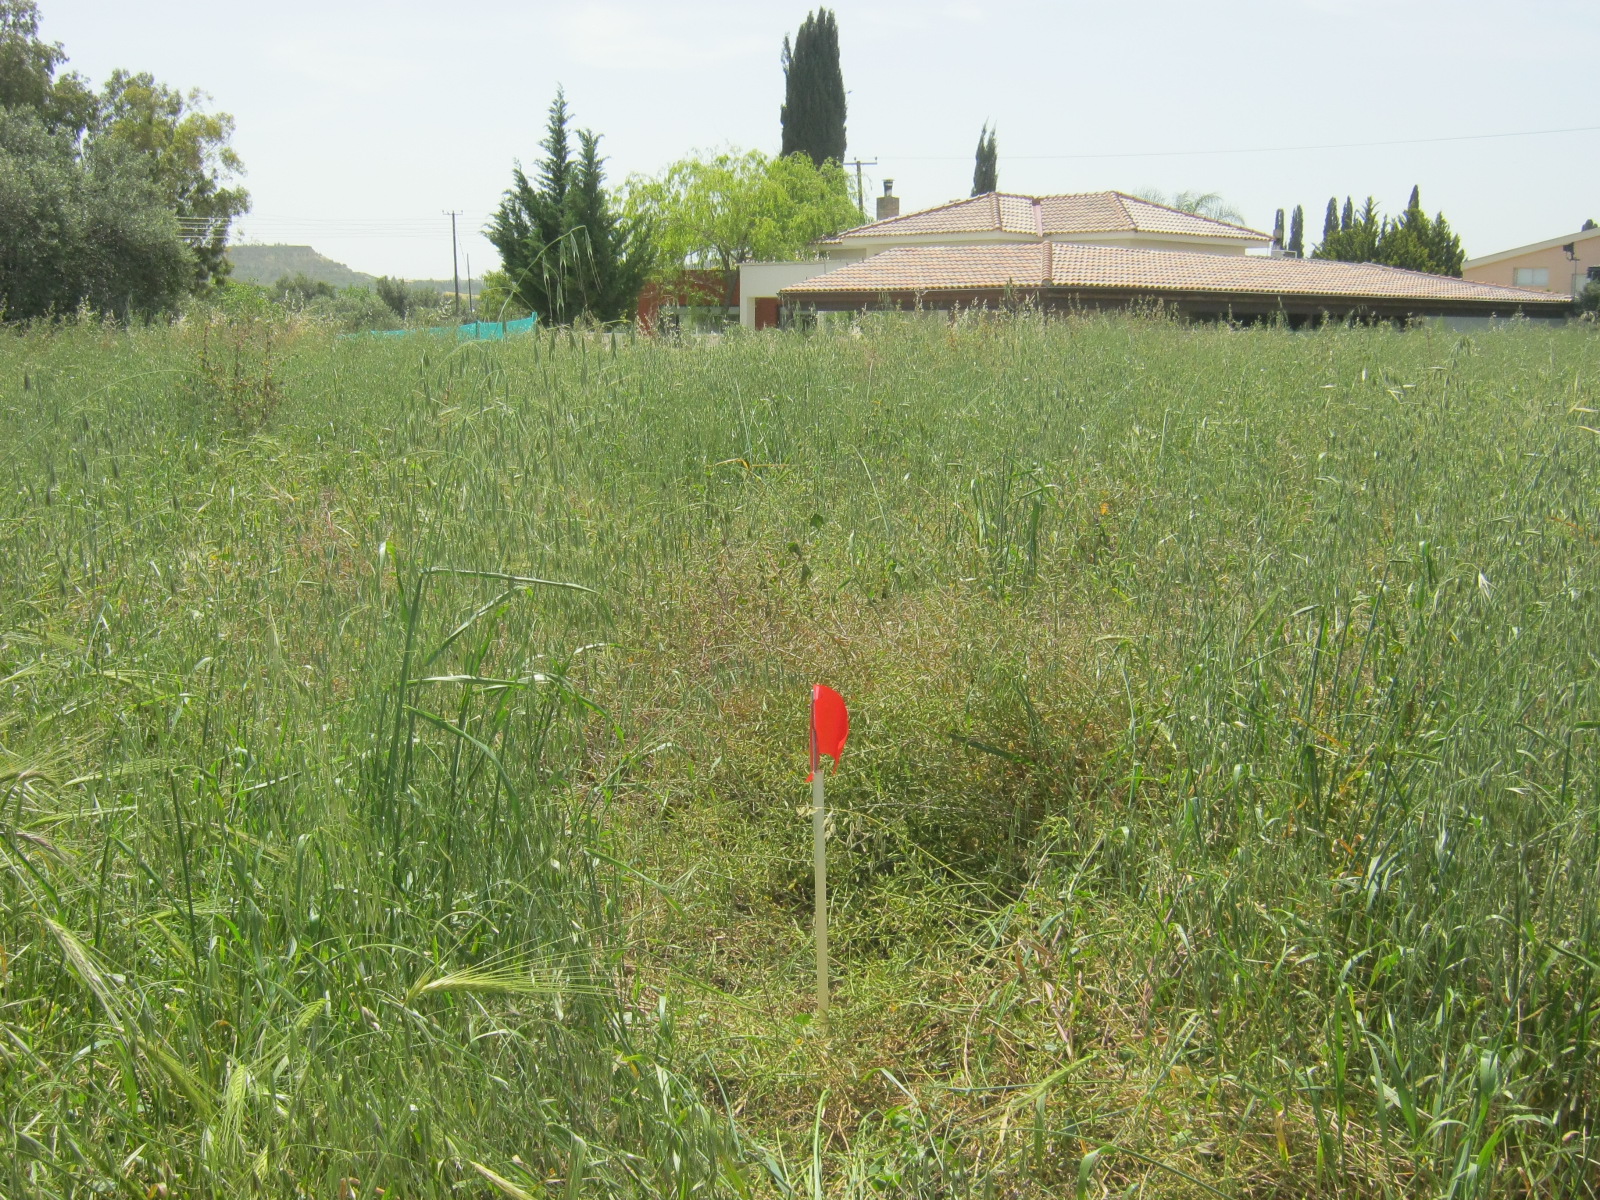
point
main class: Grassland
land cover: Spontaneously vegetated surfaces
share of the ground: > 75 %
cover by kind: herbaceous plants 100 %
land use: Residential
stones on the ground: < 10 %
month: April
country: CY
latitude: 35.0508
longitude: 33.2415
